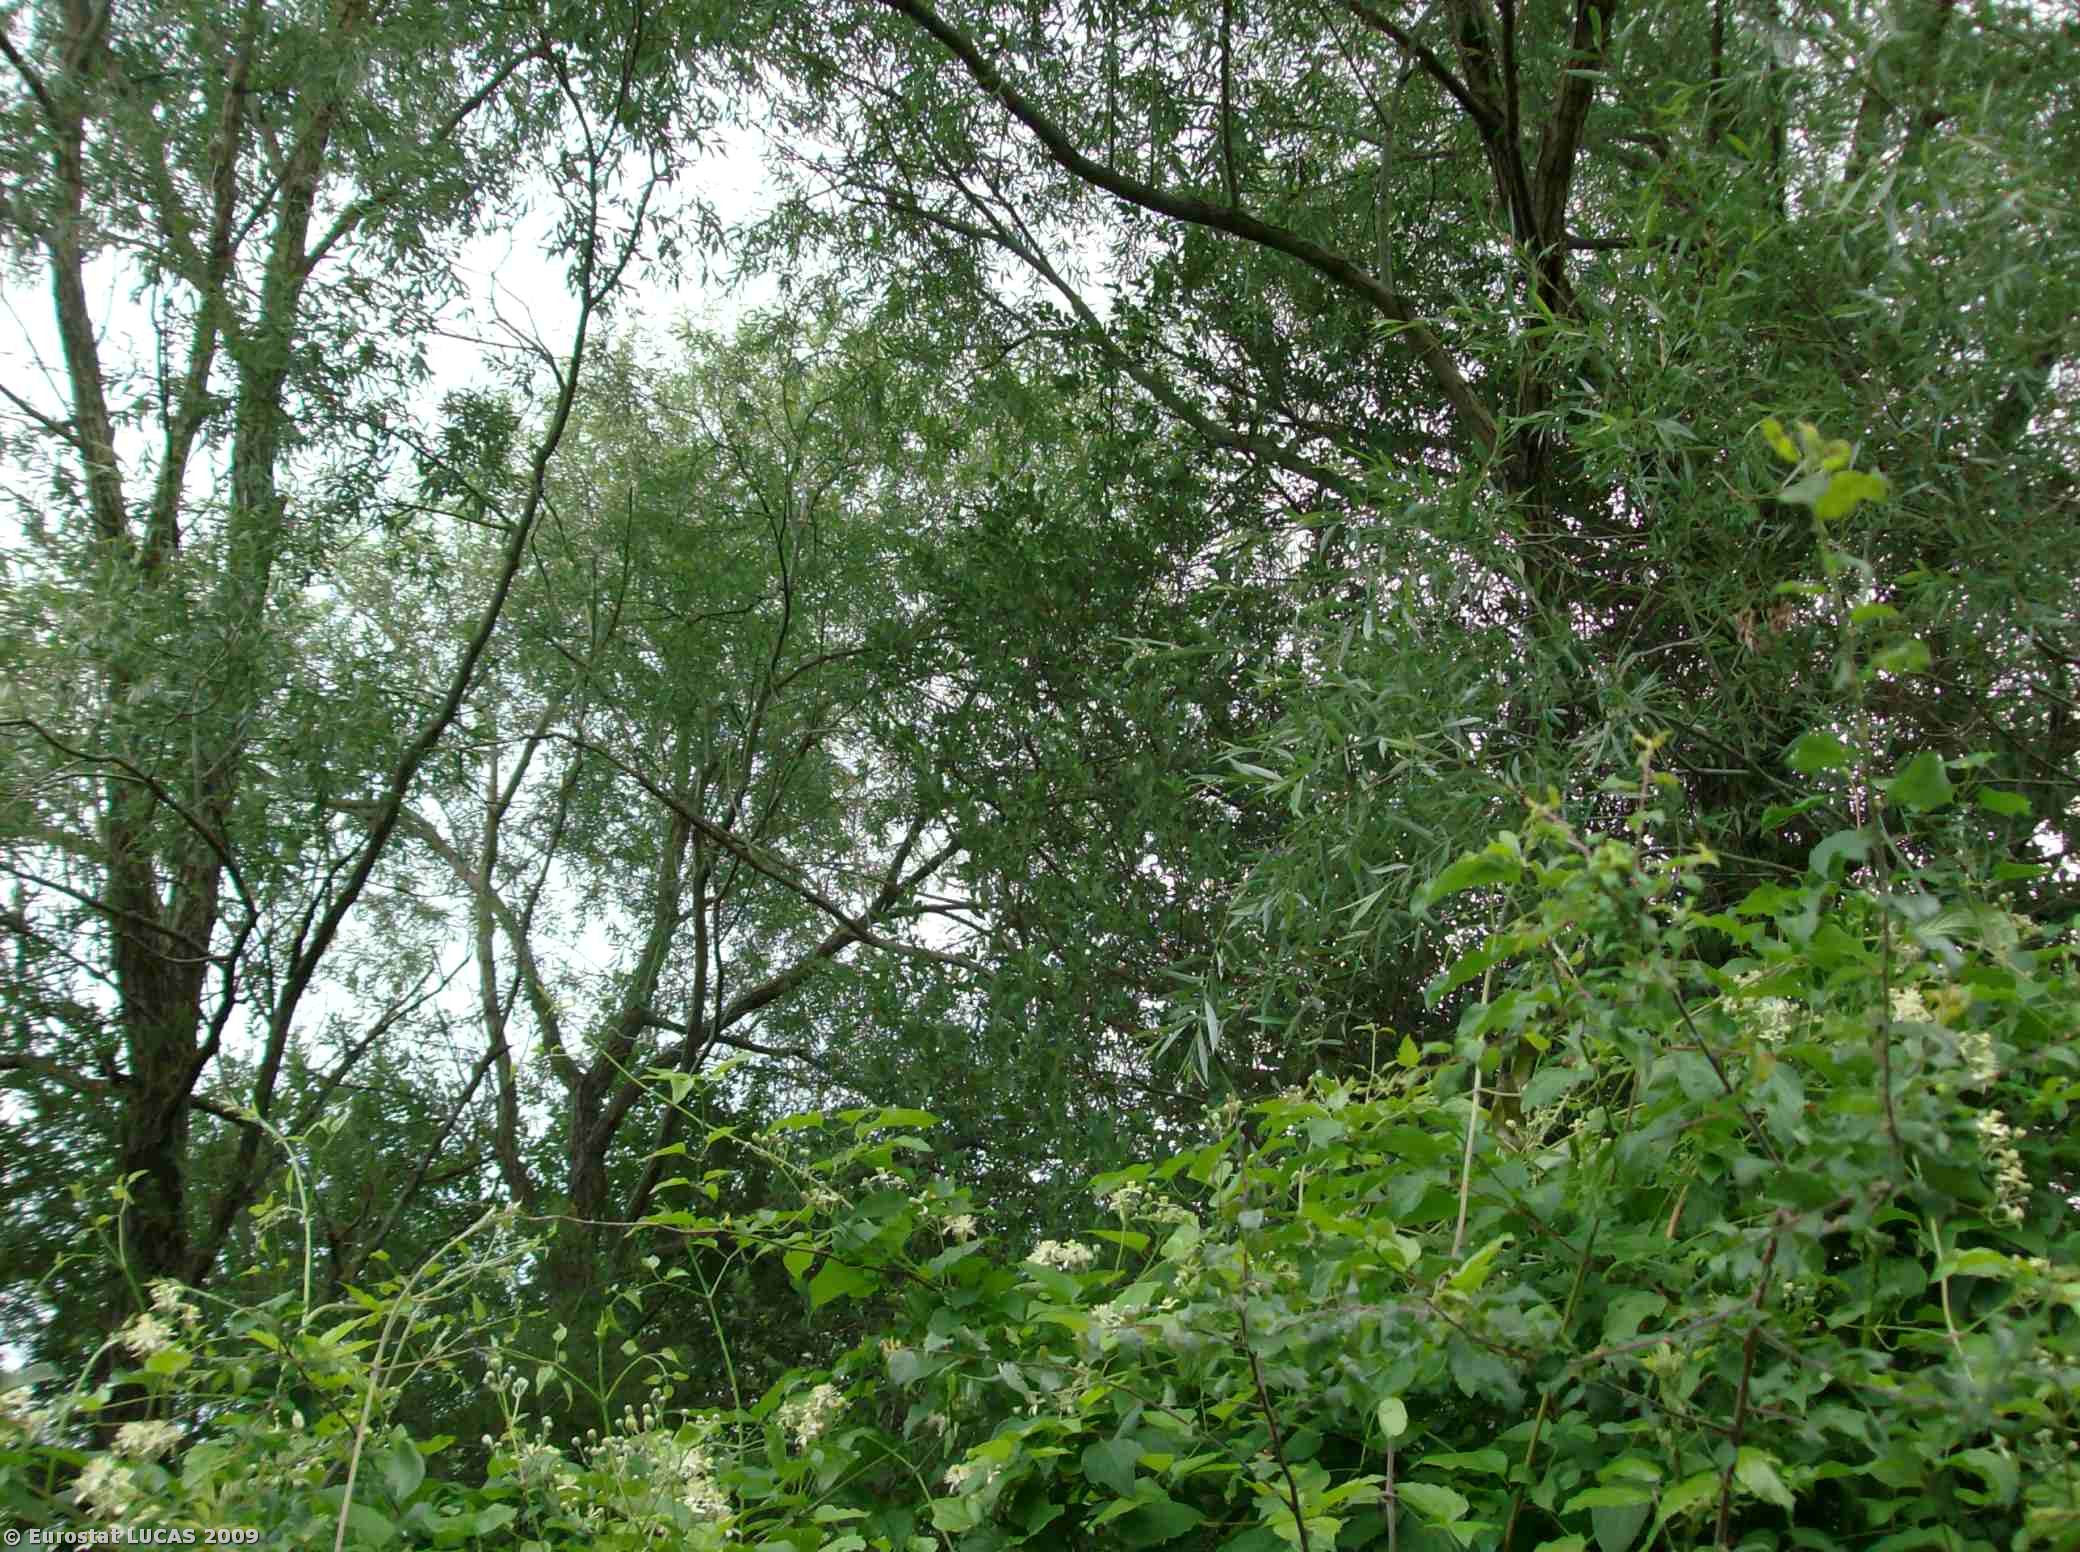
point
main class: Woodland
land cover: Broadleaved woodland
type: thermophilous deciduous forest
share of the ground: > 75 %
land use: Unused
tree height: > 5 m
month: June
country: IT
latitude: 42.8931
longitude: 11.6724
